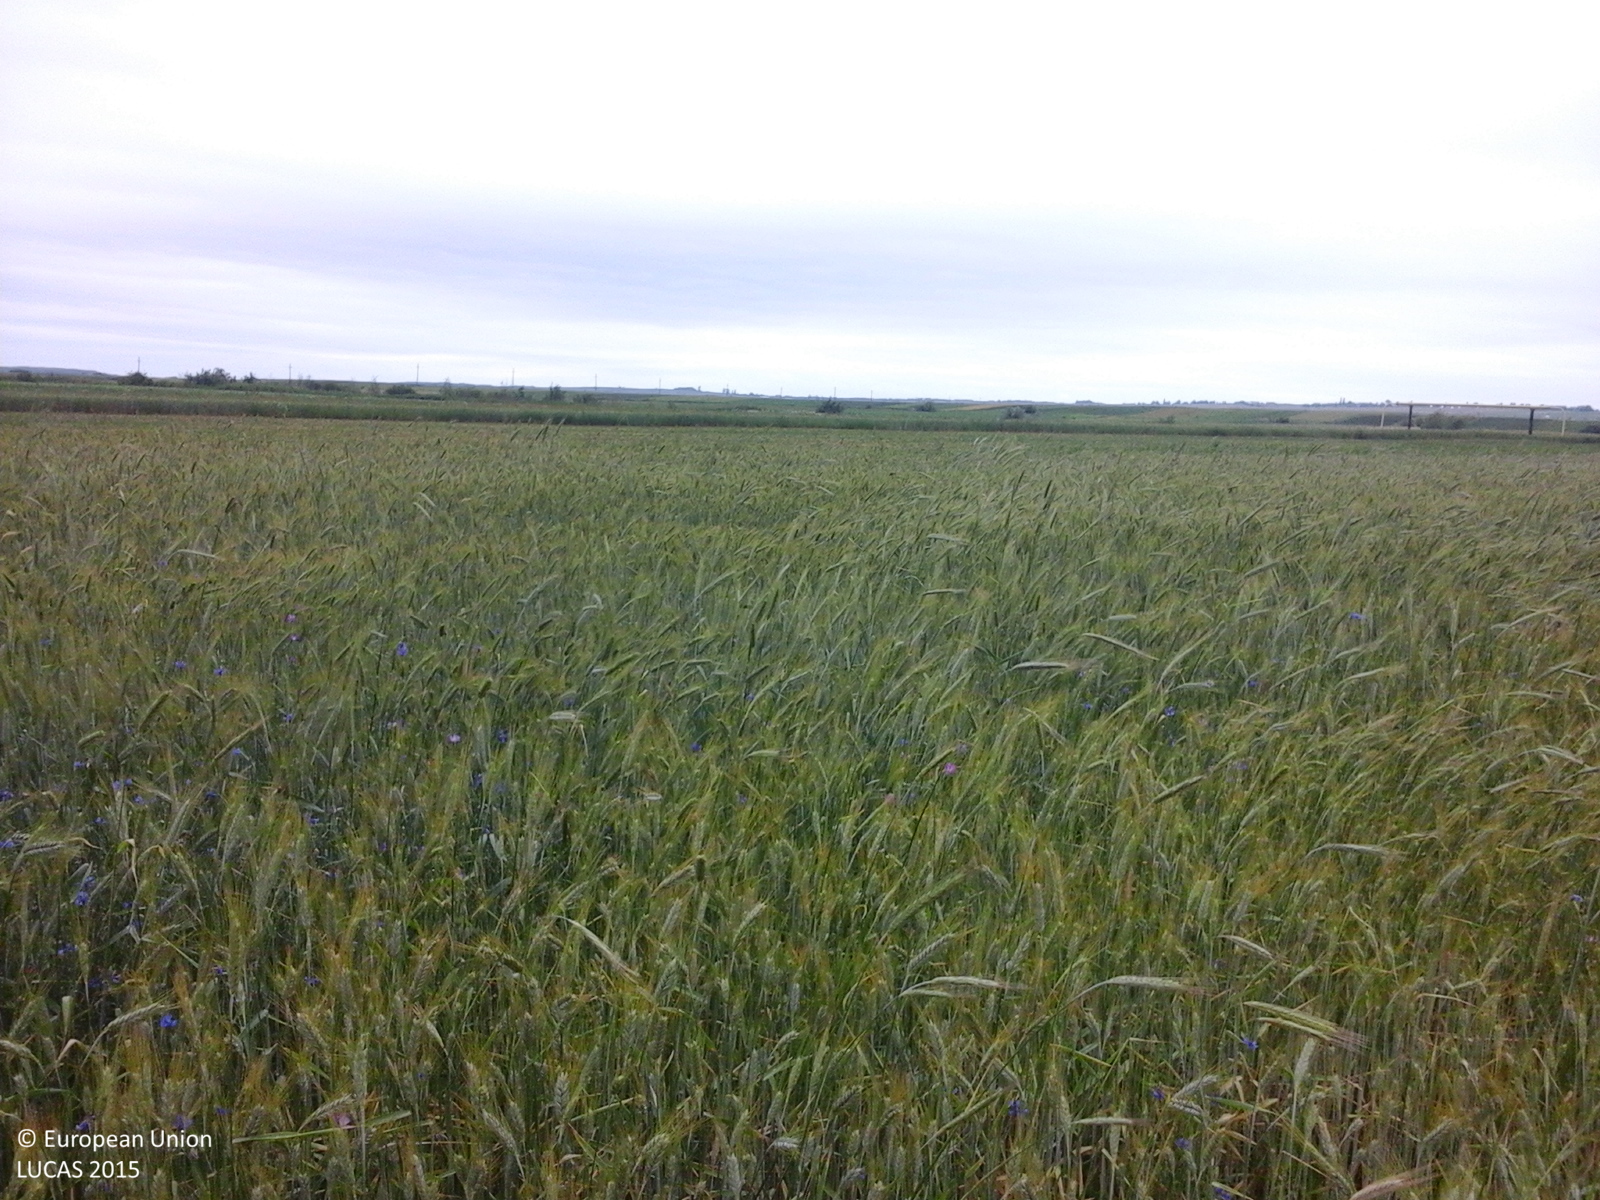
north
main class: Cropland
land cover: Common wheat
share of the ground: > 75 %
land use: Agriculture (excluding fallow land and kitchen gardens)
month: June
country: RO
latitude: 47.4343
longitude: 26.2167
